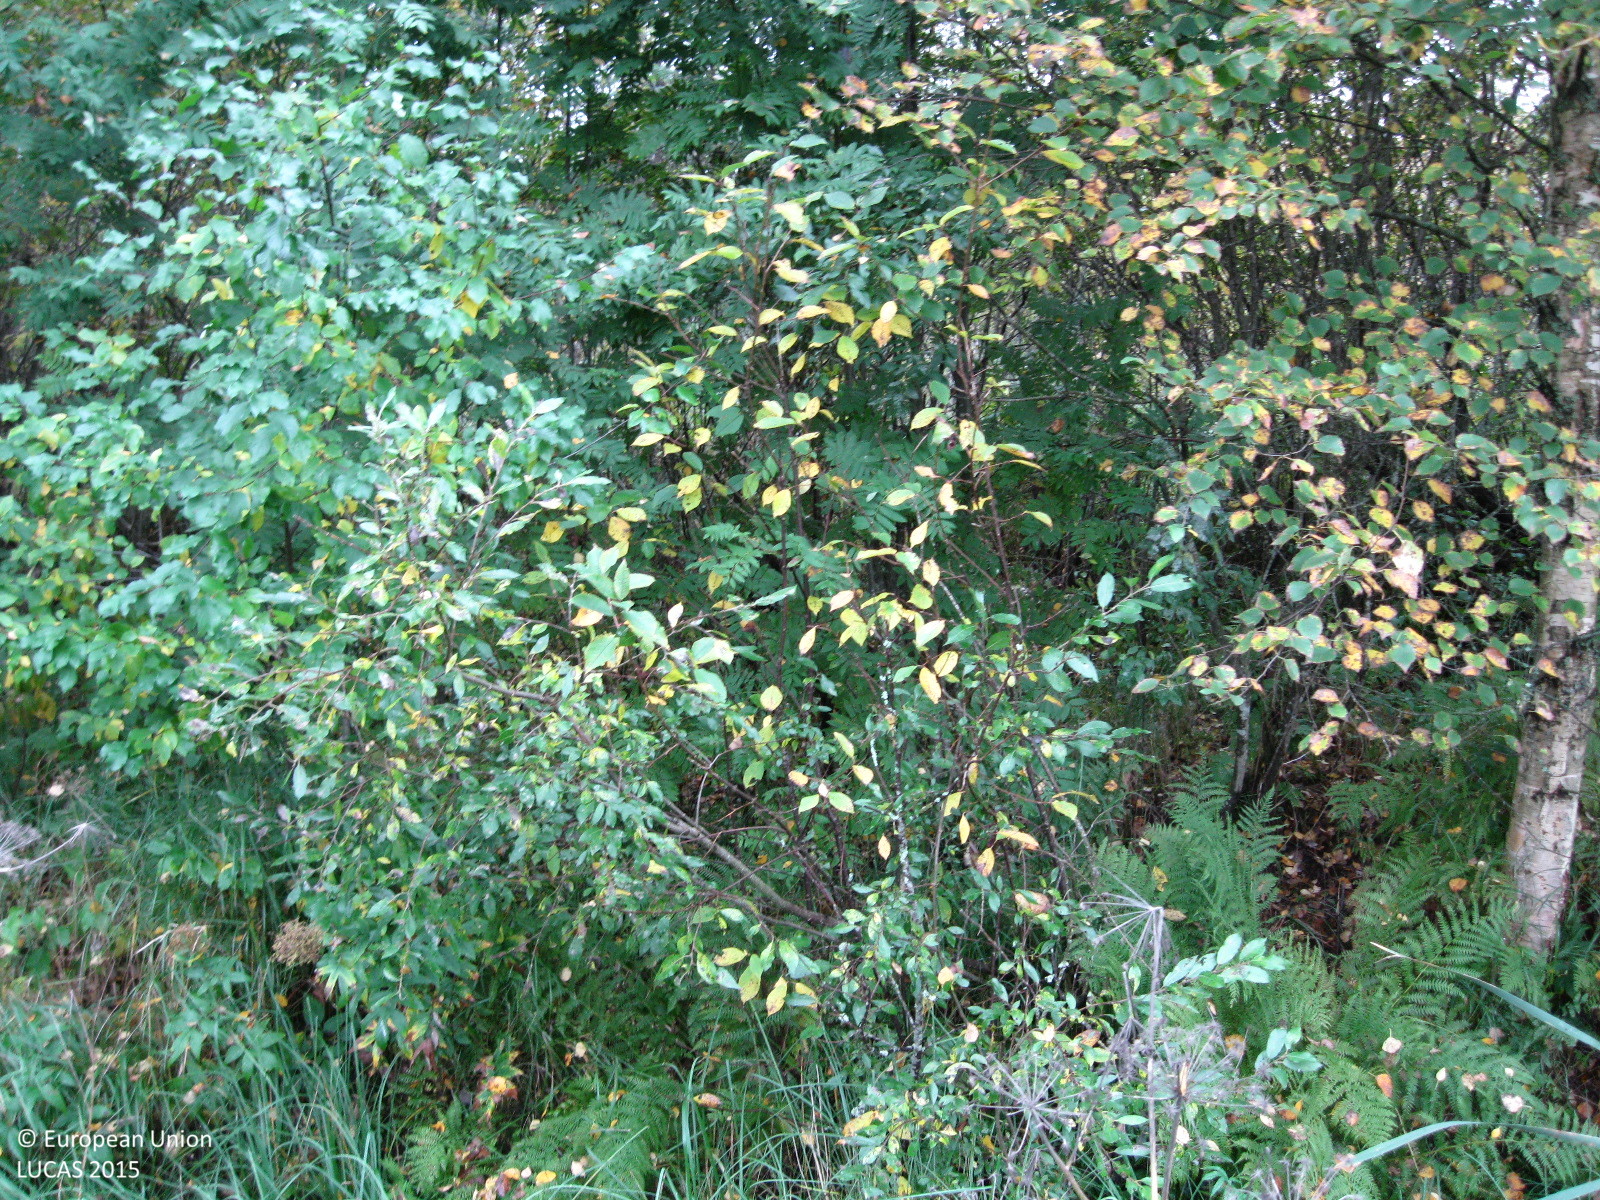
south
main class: Cropland
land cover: Barley
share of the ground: 50 - 75 %
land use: Agriculture (excluding fallow land and kitchen gardens)
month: September
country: FI
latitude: 60.8660
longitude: 24.5970
